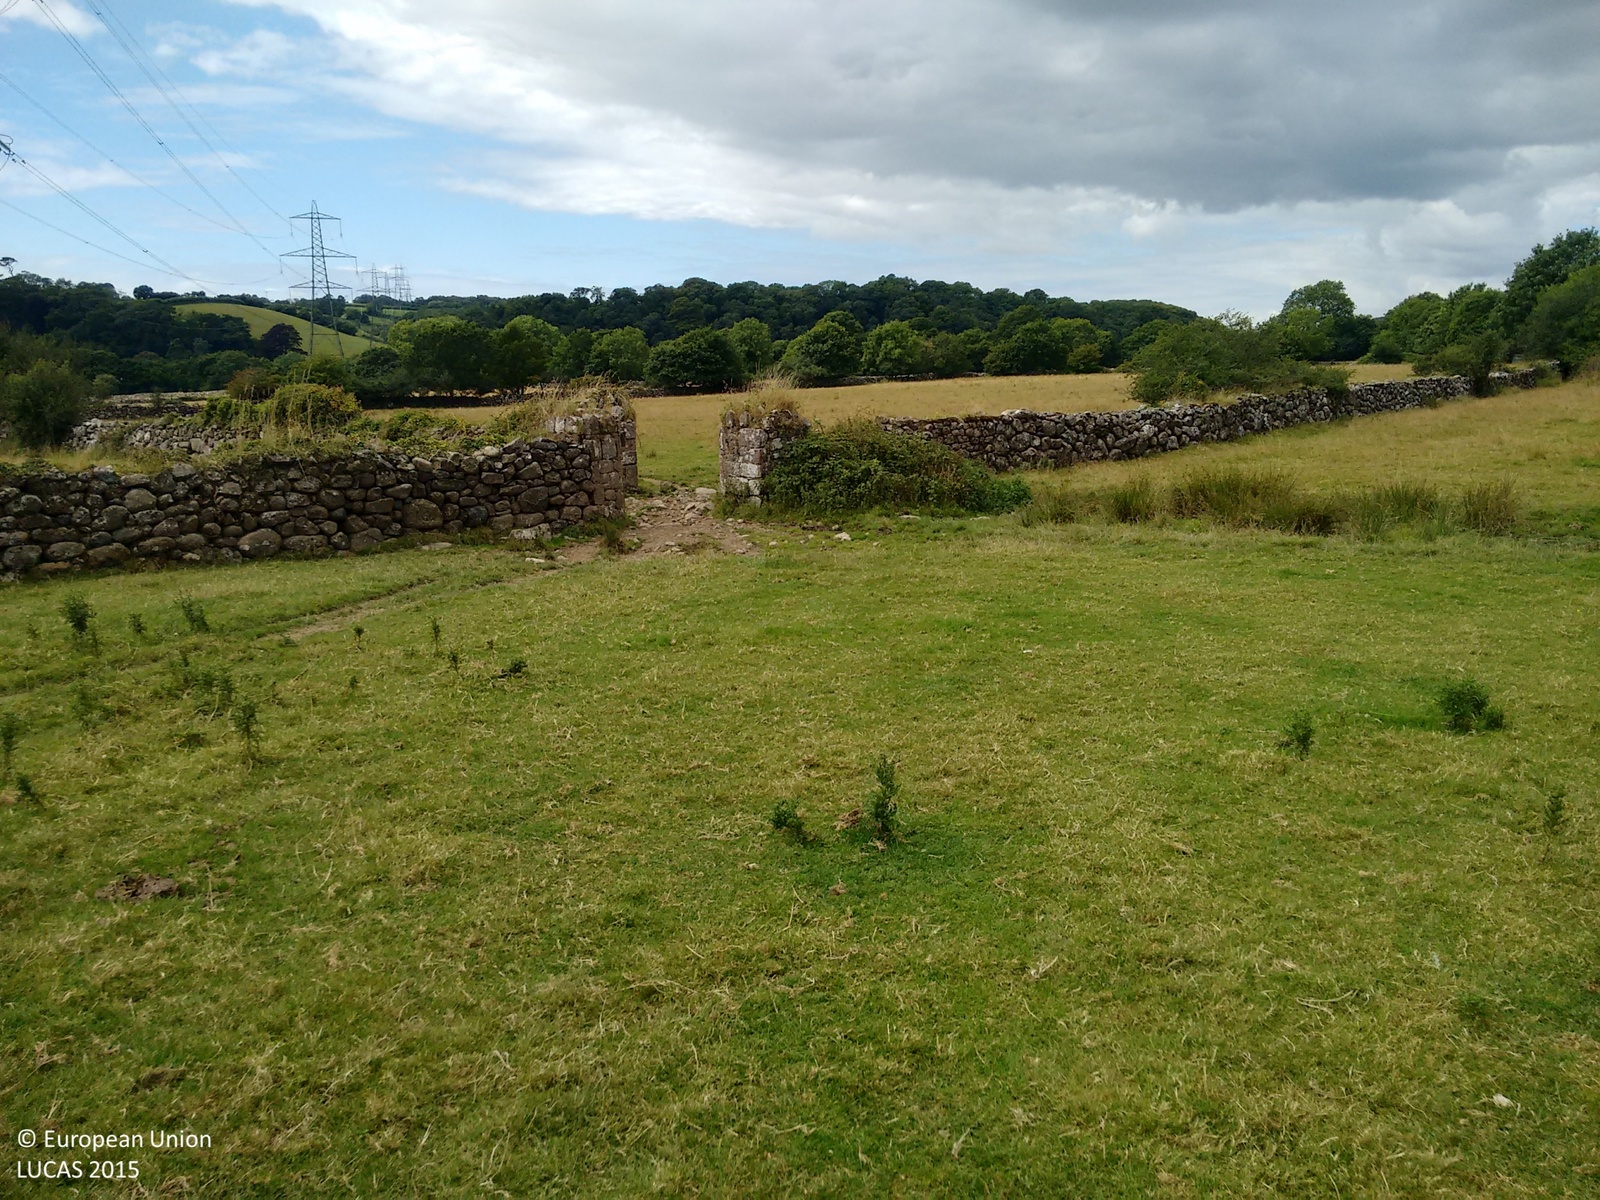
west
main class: Grassland
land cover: Grassland without tree/shrub cover
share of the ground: > 75 %
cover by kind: herbaceous plants 100 %
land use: Agriculture (excluding fallow land and kitchen gardens)
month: August
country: GB
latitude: 50.3841
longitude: -3.9165
